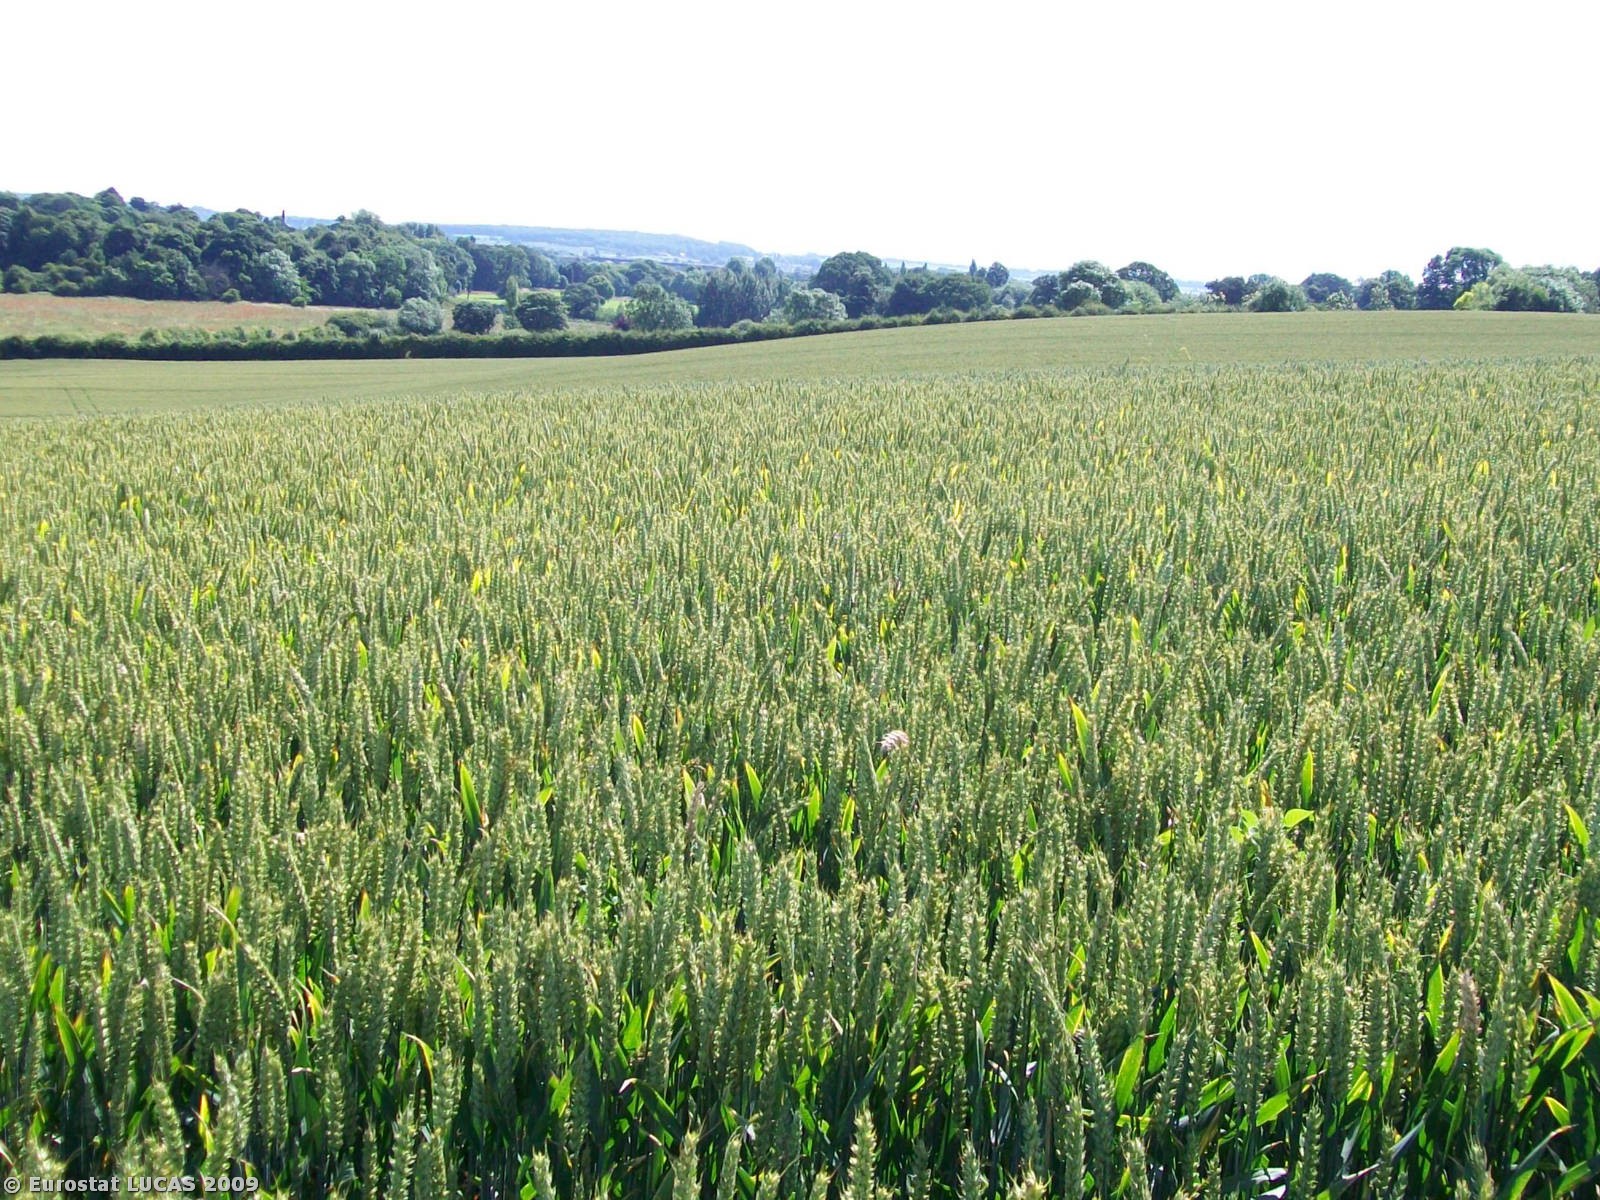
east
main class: Cropland
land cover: Common wheat
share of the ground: > 75 %
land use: Agriculture (excluding fallow land and kitchen gardens)
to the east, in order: Common wheat; Grass margins; Managed hedges; Grass margins; Common wheat
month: July
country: GB
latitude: 53.6475
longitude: -1.3484
